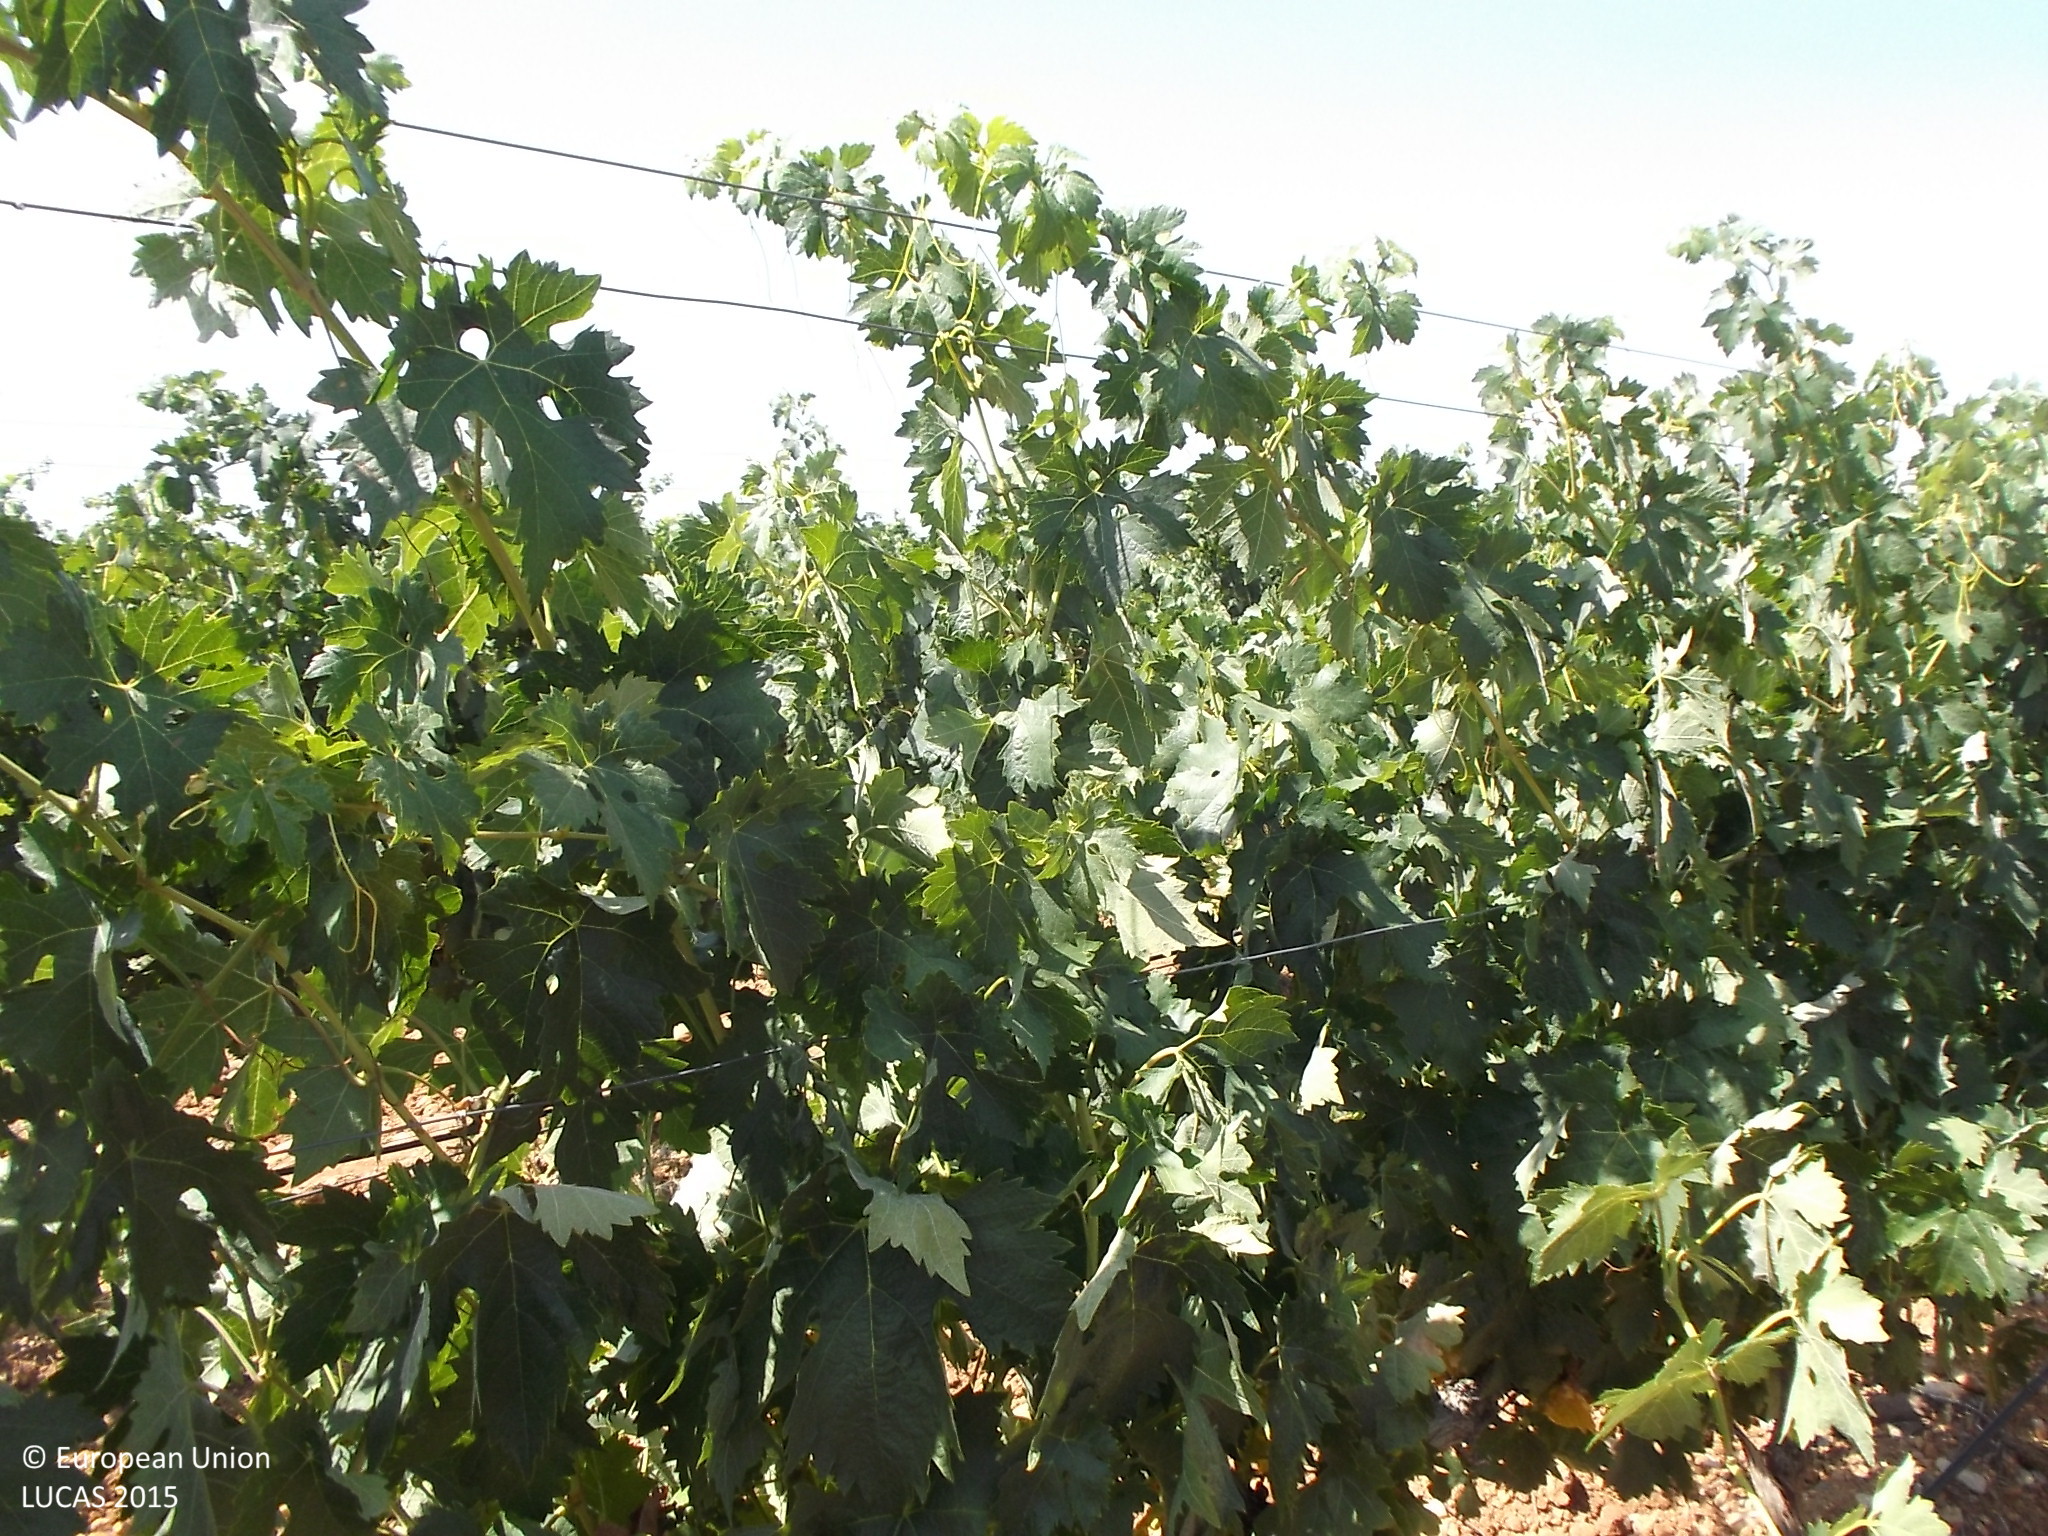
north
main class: Cropland
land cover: Vineyards
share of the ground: 10 - 25 %
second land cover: Other bare soil
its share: > 75 %
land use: Agriculture (excluding fallow land and kitchen gardens)
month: July
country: ES
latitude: 41.4837
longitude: -5.2995
